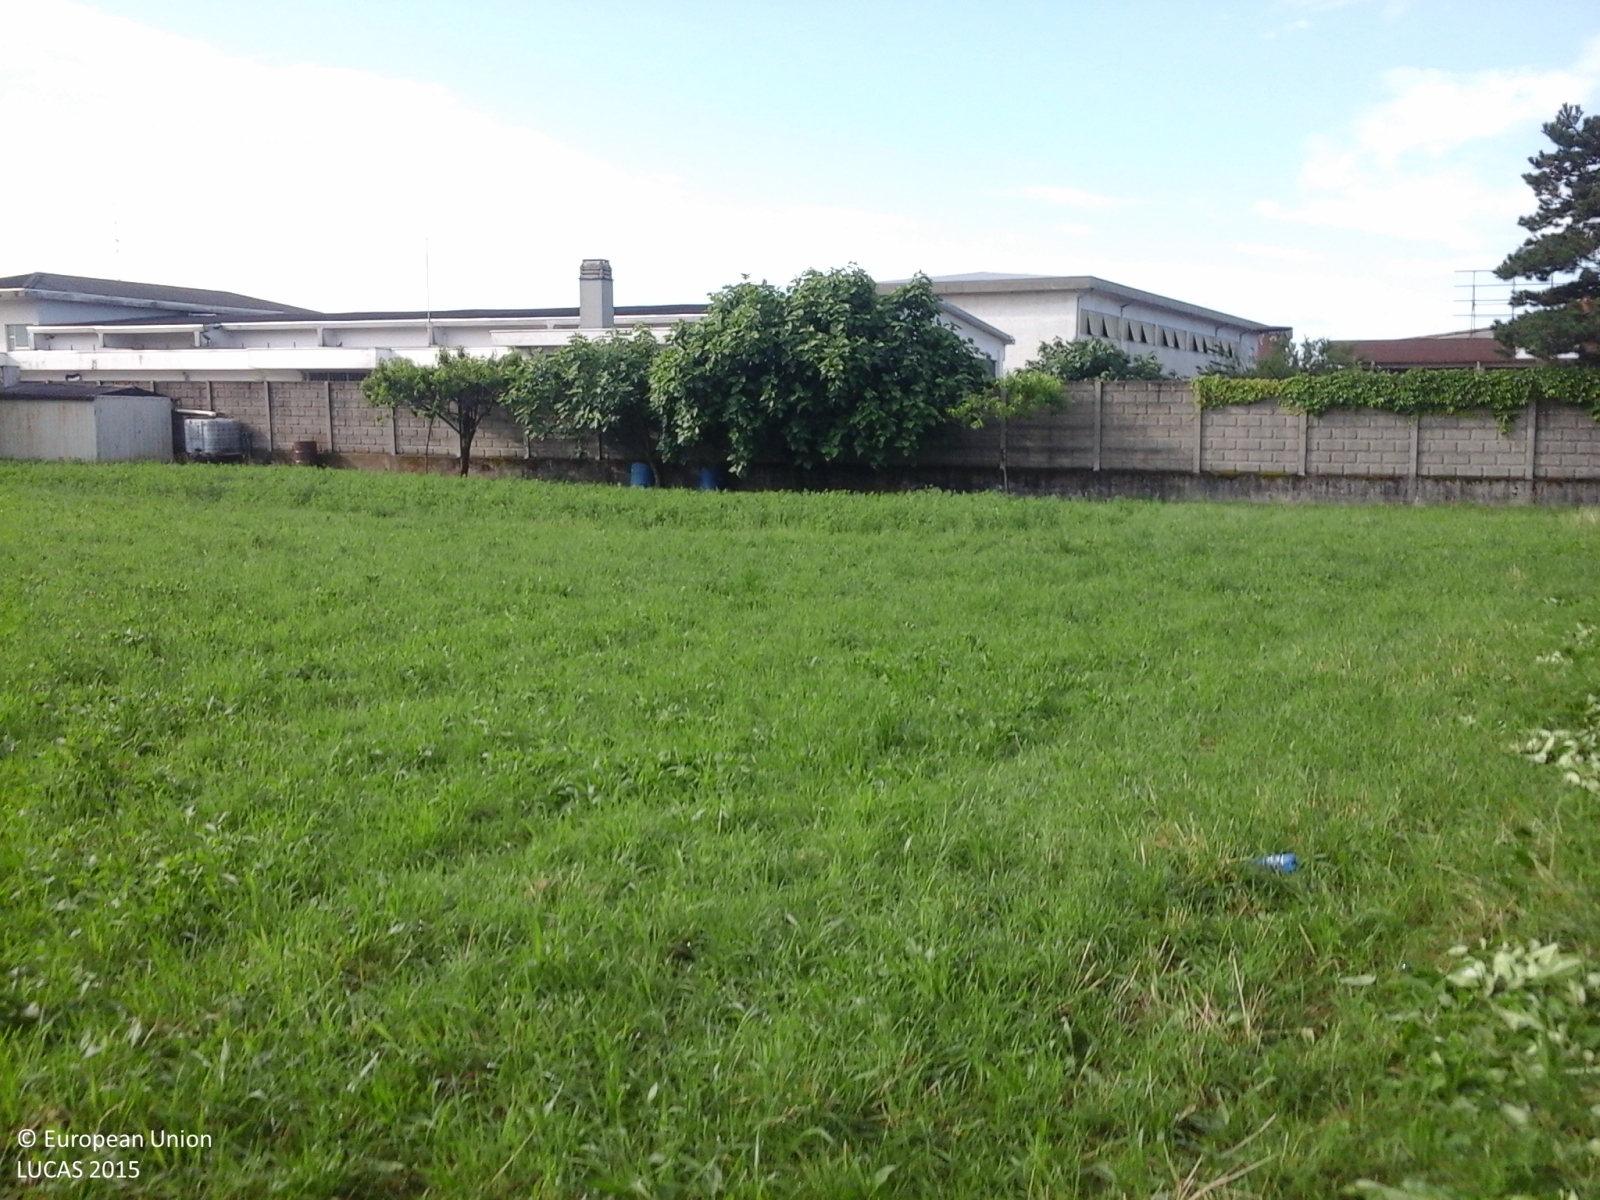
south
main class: Grassland
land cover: Grassland without tree/shrub cover
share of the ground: > 75 %
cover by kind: herbaceous plants 100 %
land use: Agriculture (excluding fallow land and kitchen gardens)
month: June
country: IT
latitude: 45.6416
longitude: 8.7831
